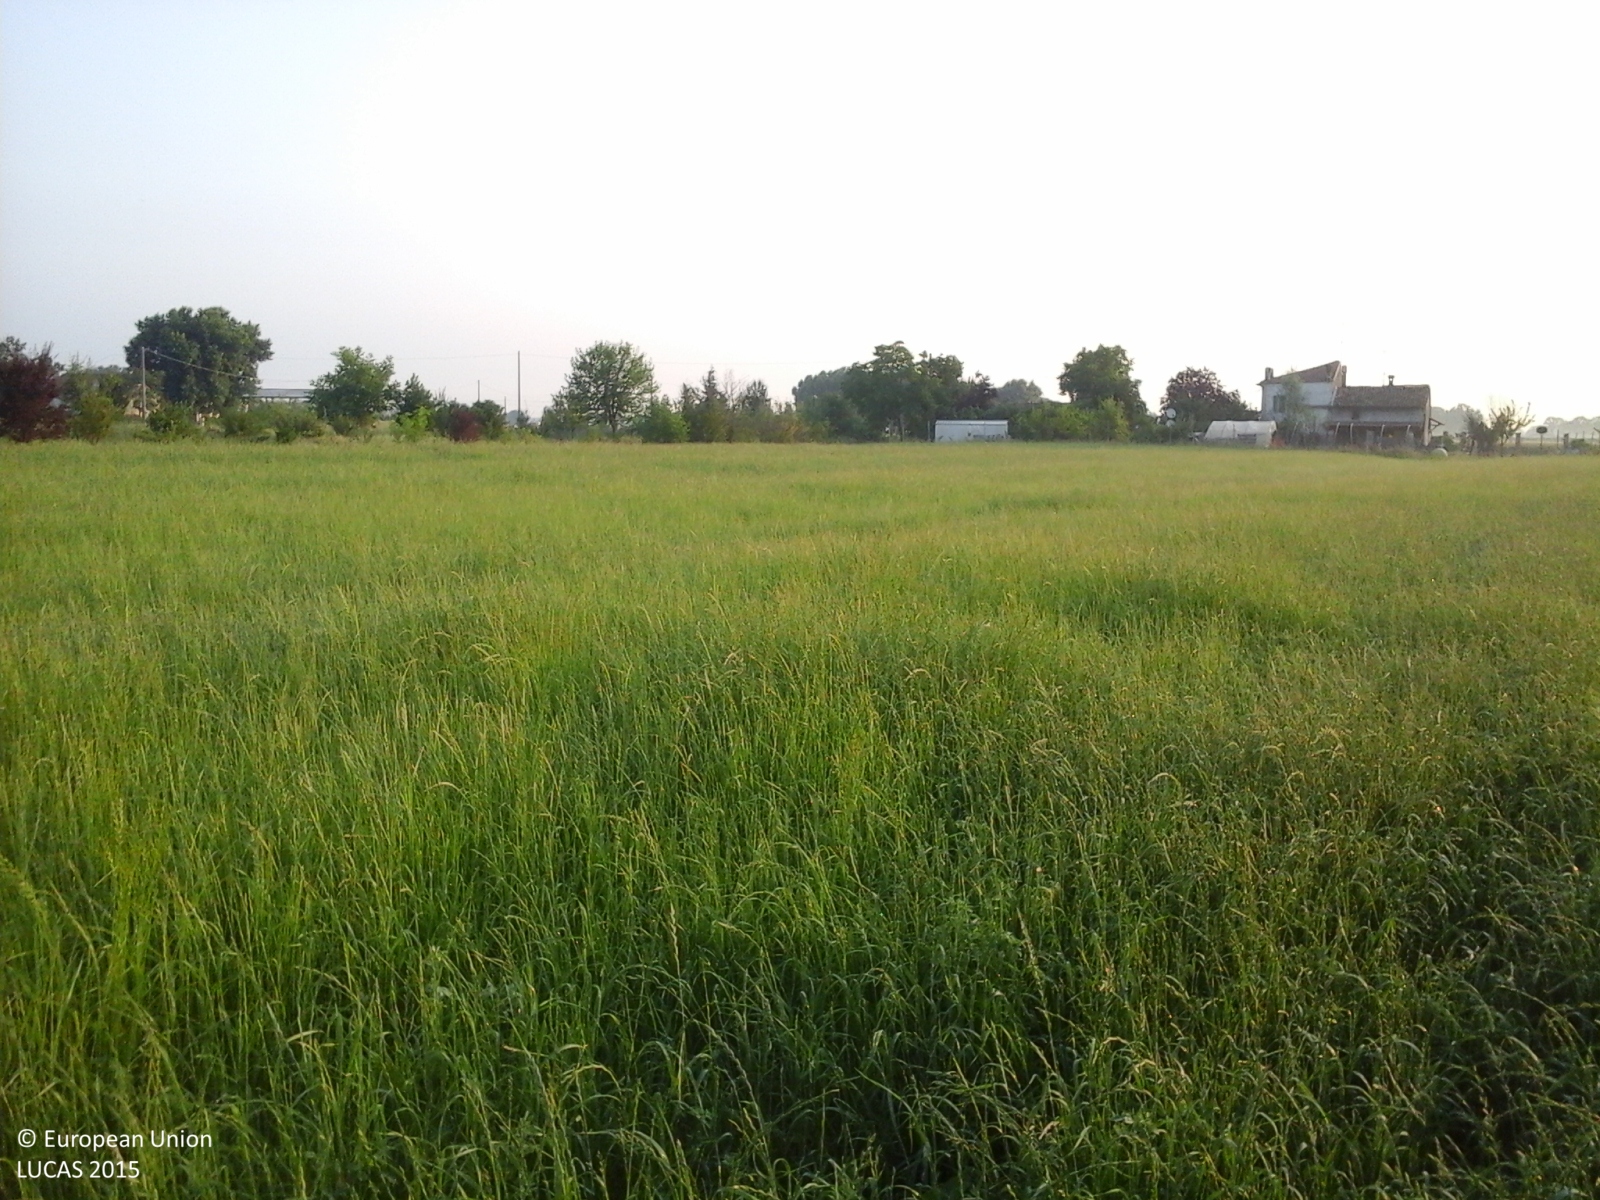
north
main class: Cropland
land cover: Temporary grasslands
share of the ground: > 75 %
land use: Agriculture (excluding fallow land and kitchen gardens)
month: June
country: IT
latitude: 44.9276
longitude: 10.0126
